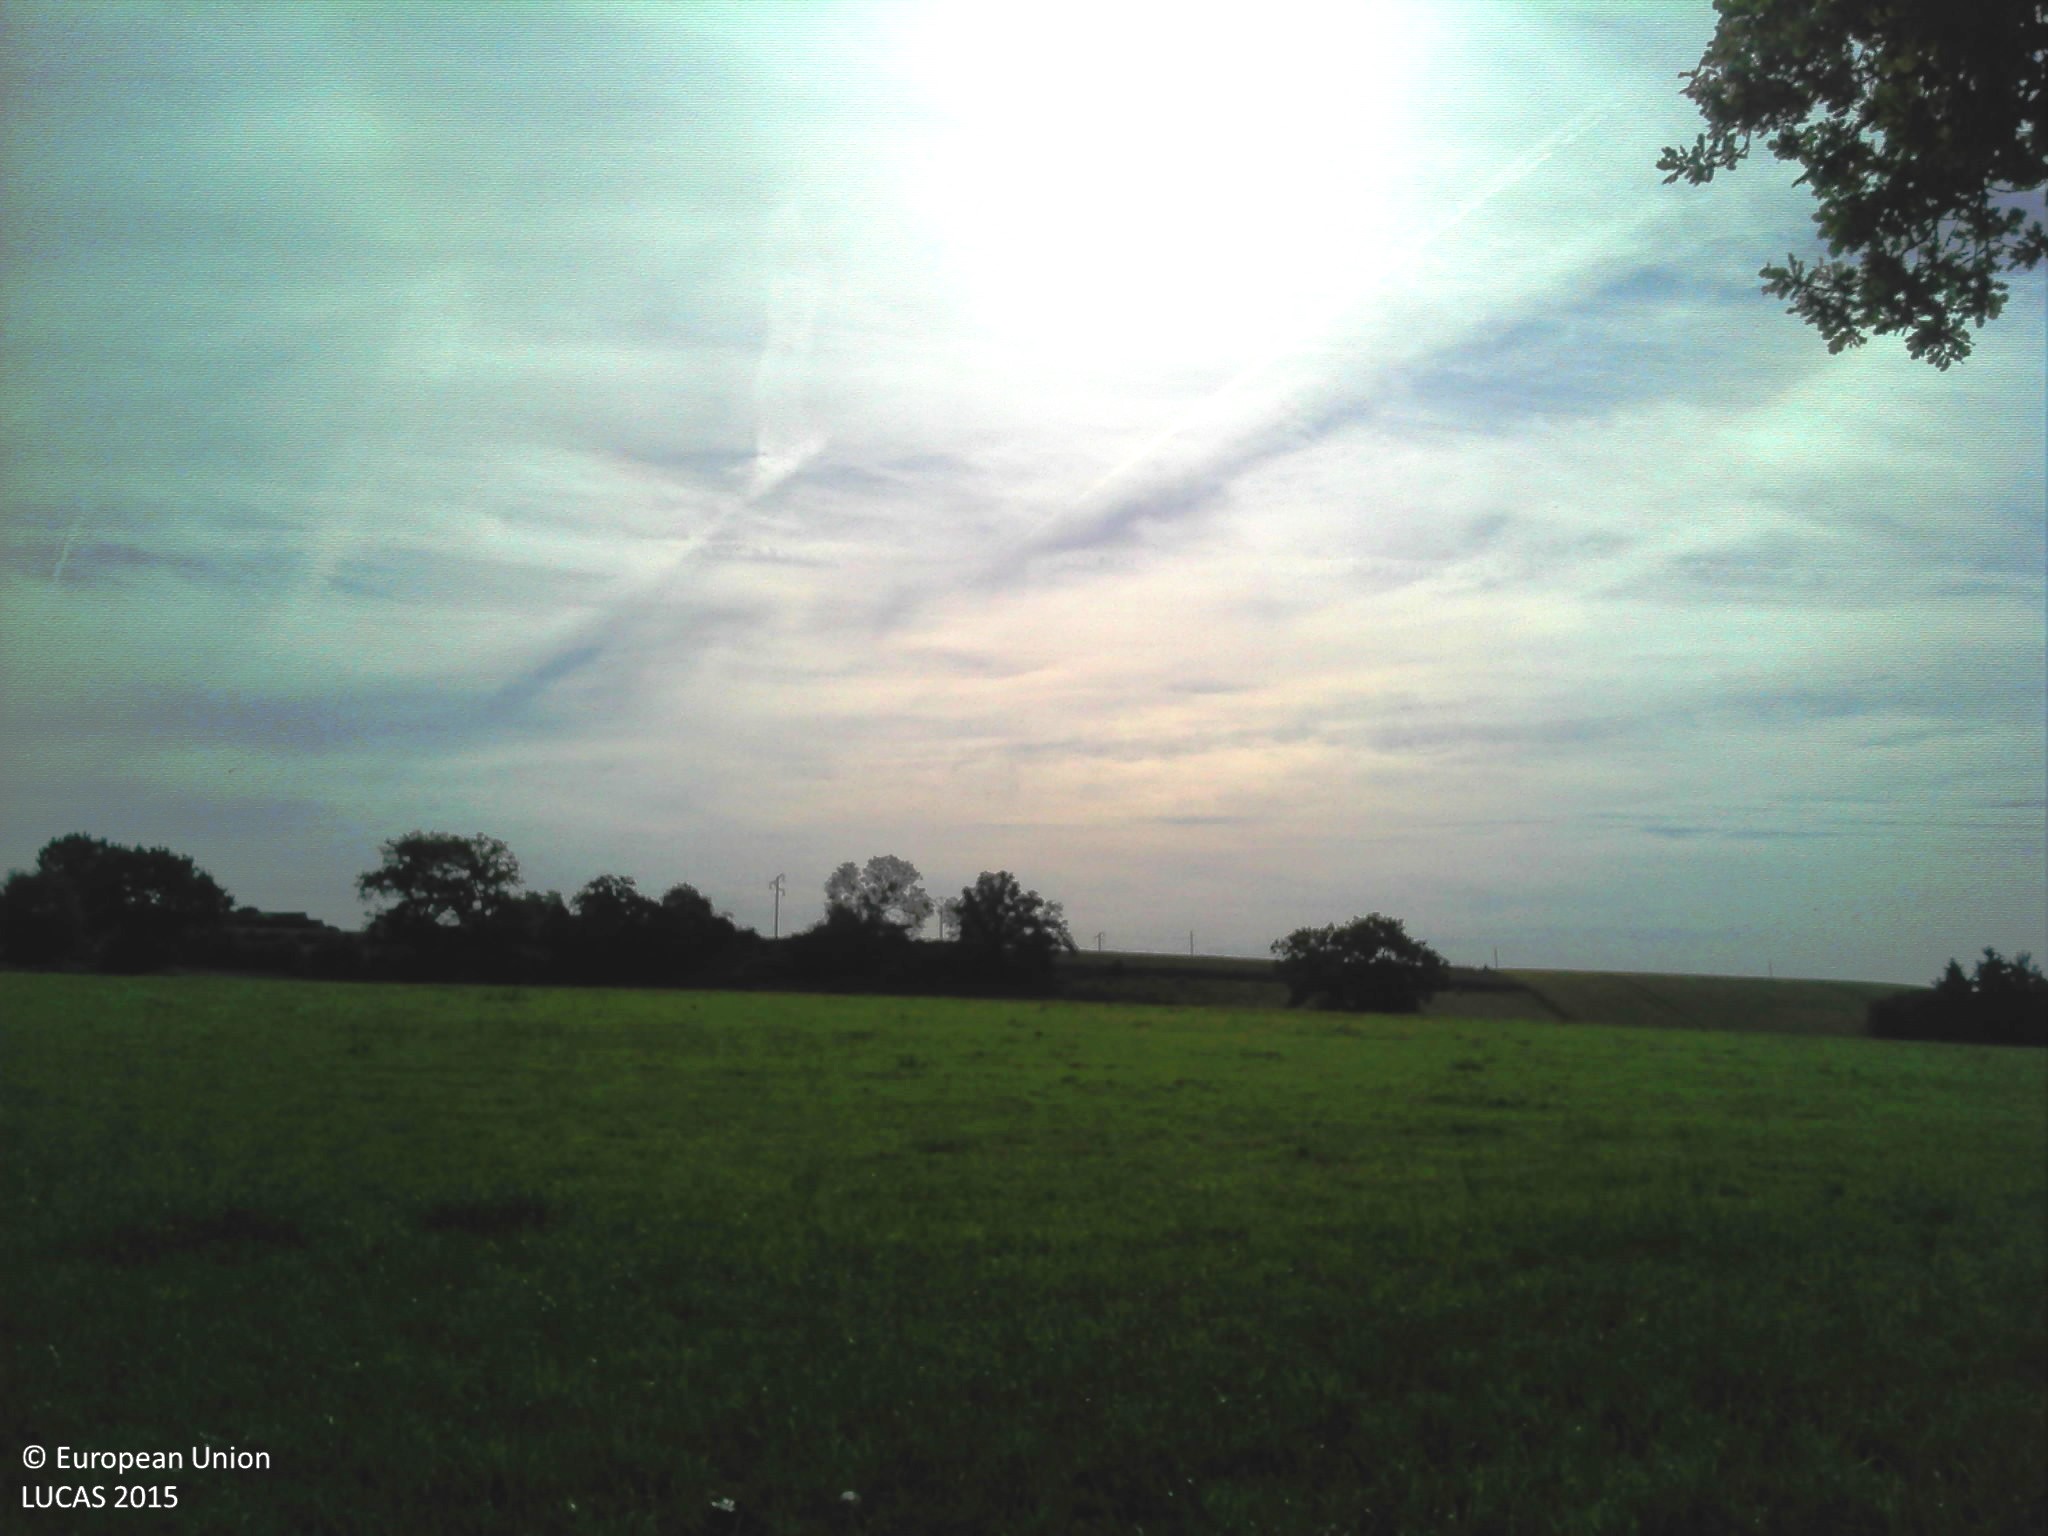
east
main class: Woodland
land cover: Broadleaved woodland
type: acidophilous oak and oak-birch forest
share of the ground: > 75 %
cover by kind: broadleaved forest trees 70 %, shrubs 15 %, herbaceous plants 15 %
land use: Forestry
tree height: > 5 m
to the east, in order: Broadleaved woodland; Ditches and canals; Fences; Grassland without tree/shrub cover; Fences; Abandoned hedges; Fences; Grassland without tree/shrub cover; Fences; Ditches and canals; Fences
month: June
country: FR
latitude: 48.3493
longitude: 0.2170
